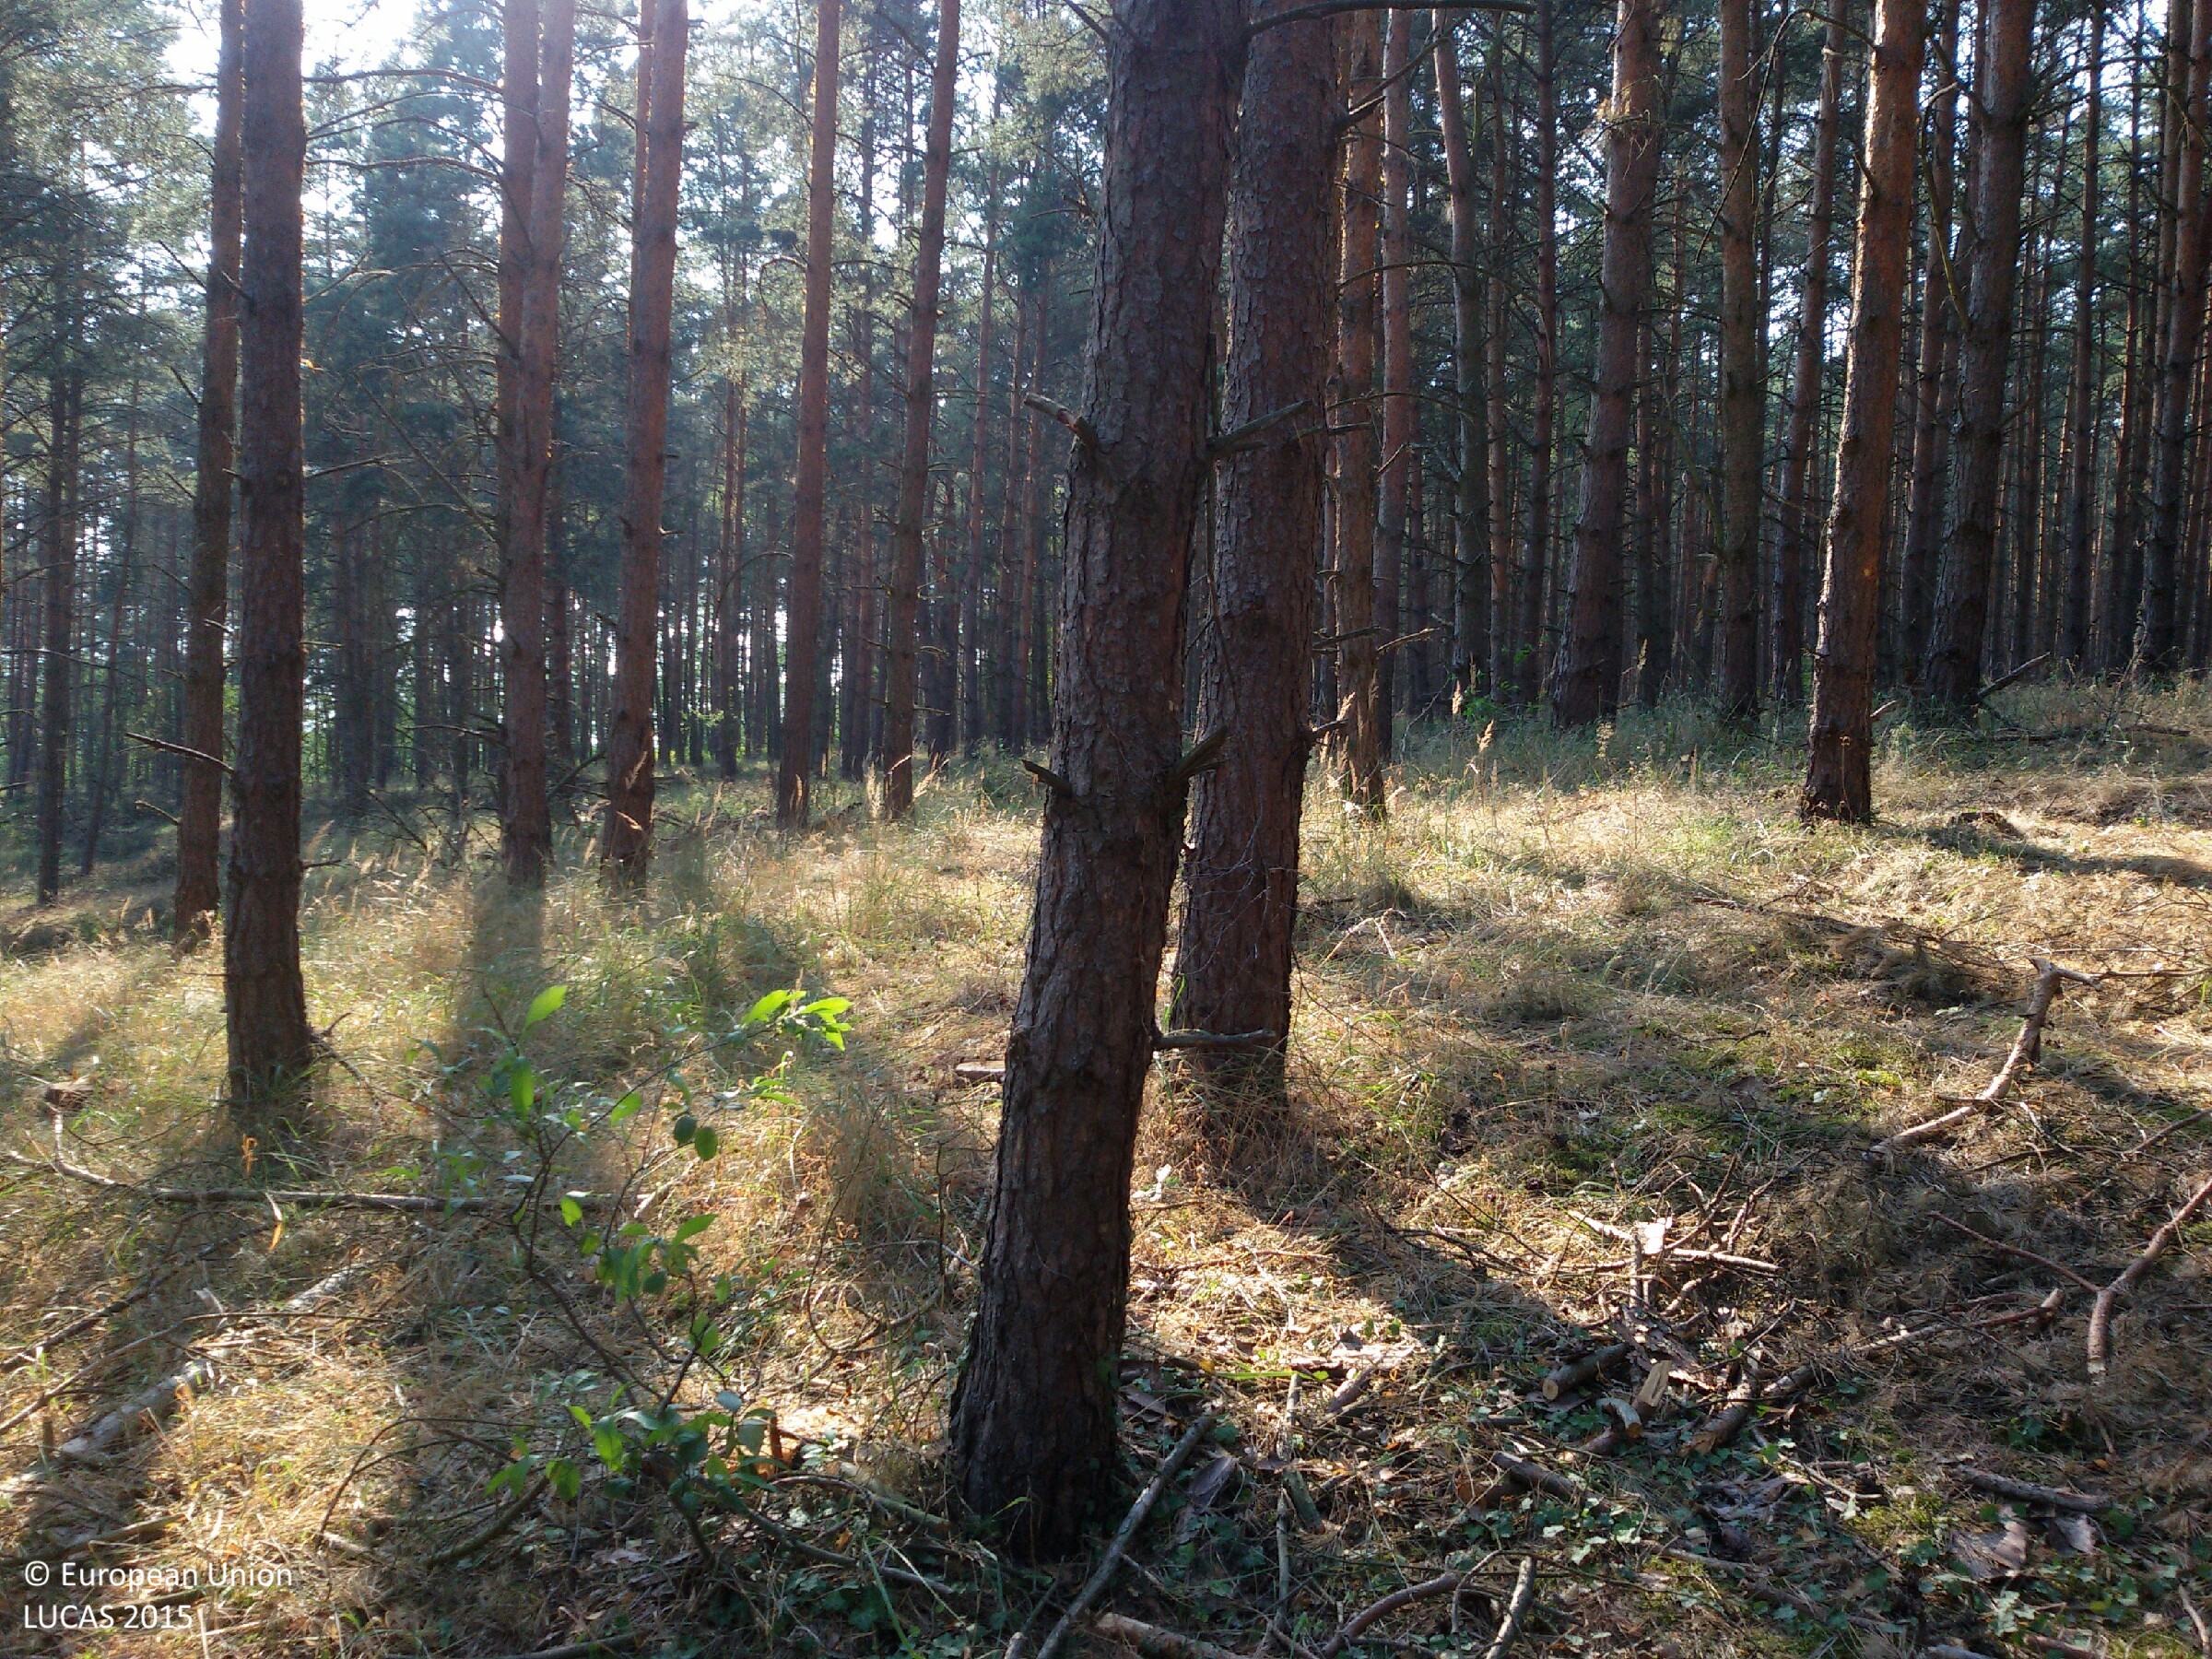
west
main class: Woodland
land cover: Pine dominated mixed woodland
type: hemiboreal forest and nemoral coniferous forest and mixed broadleaved-coniferous forest
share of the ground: > 75 %
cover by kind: coniferous forest trees 55 %, broadleaved forest trees 20 %, herbaceous plants 20 %, lichens and mosses 5 %
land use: Forestry
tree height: > 5 m
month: August
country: PL
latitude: 52.8051
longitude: 14.2583
